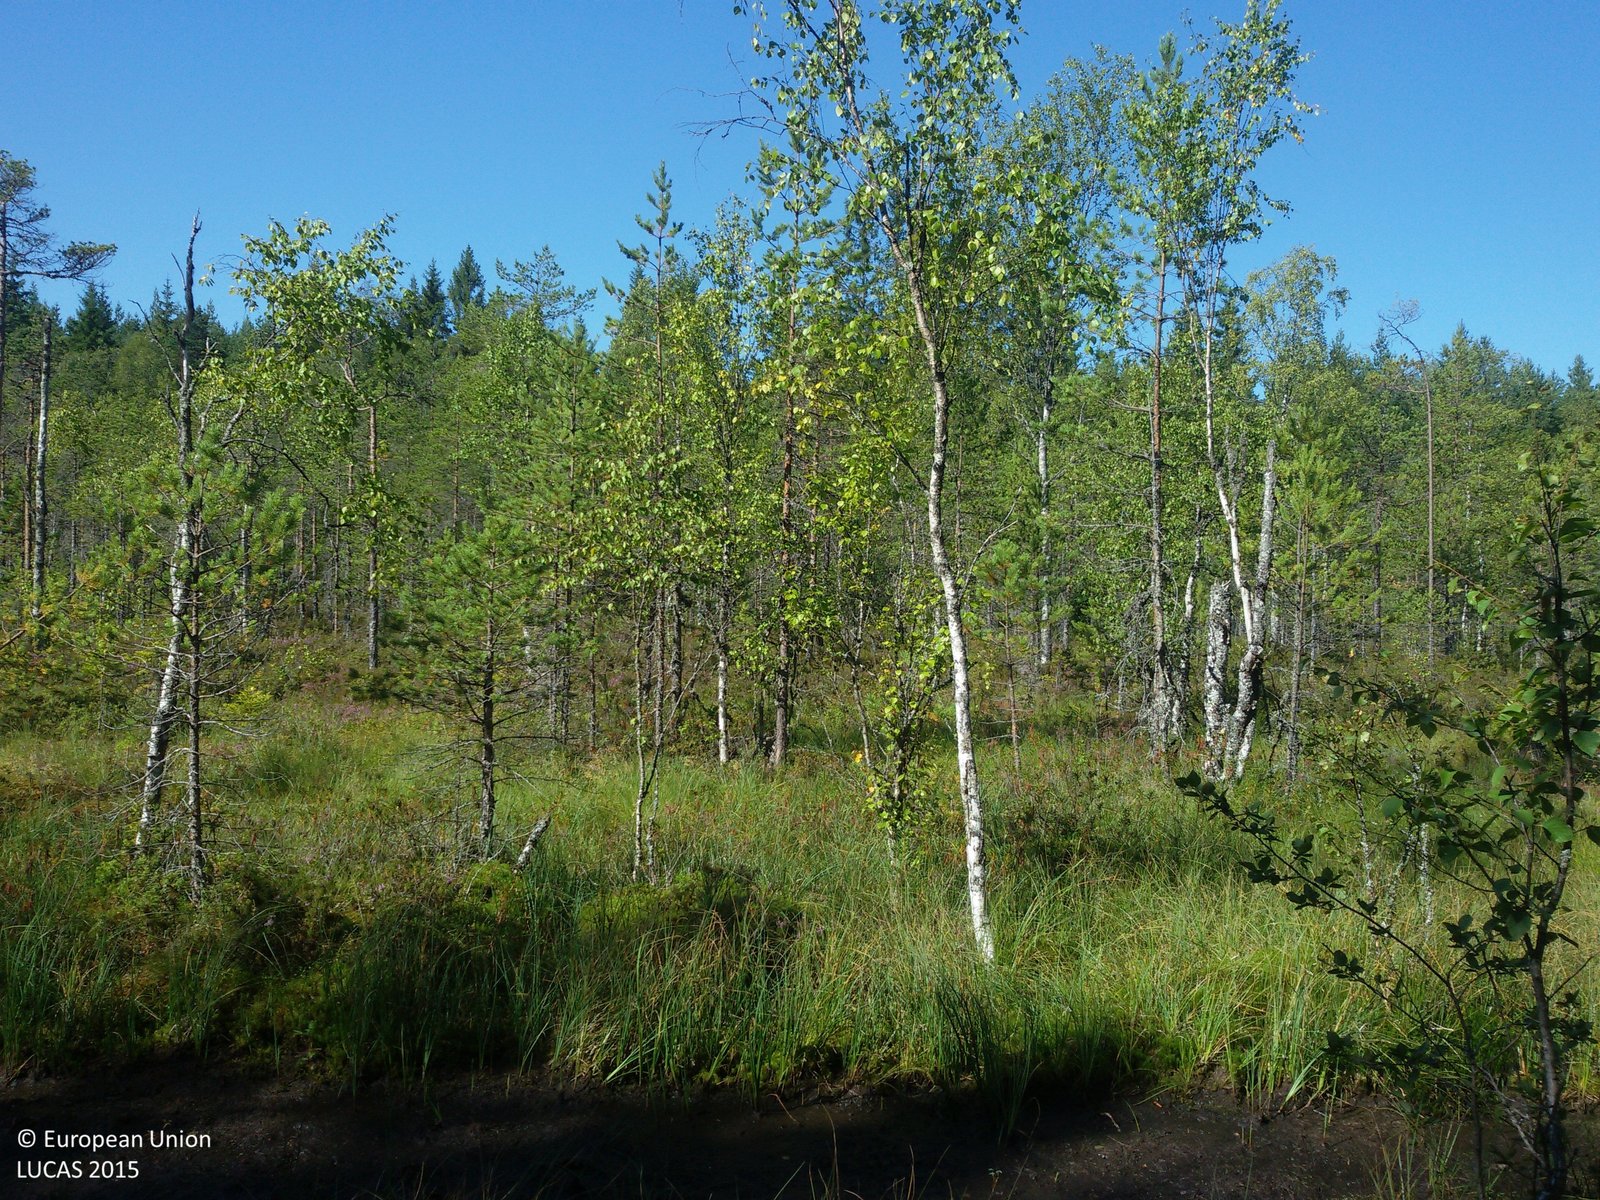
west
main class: Woodland
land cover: Pine dominated coniferous woodland
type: boreal forest
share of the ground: 50 - 75 %
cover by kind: coniferous forest trees 45 %, herbaceous plants 20 %, lichens and mosses 20 %, broadleaved forest trees 15 %
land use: Forestry
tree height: > 5 m
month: August
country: SE
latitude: 60.6340
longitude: 15.9287
